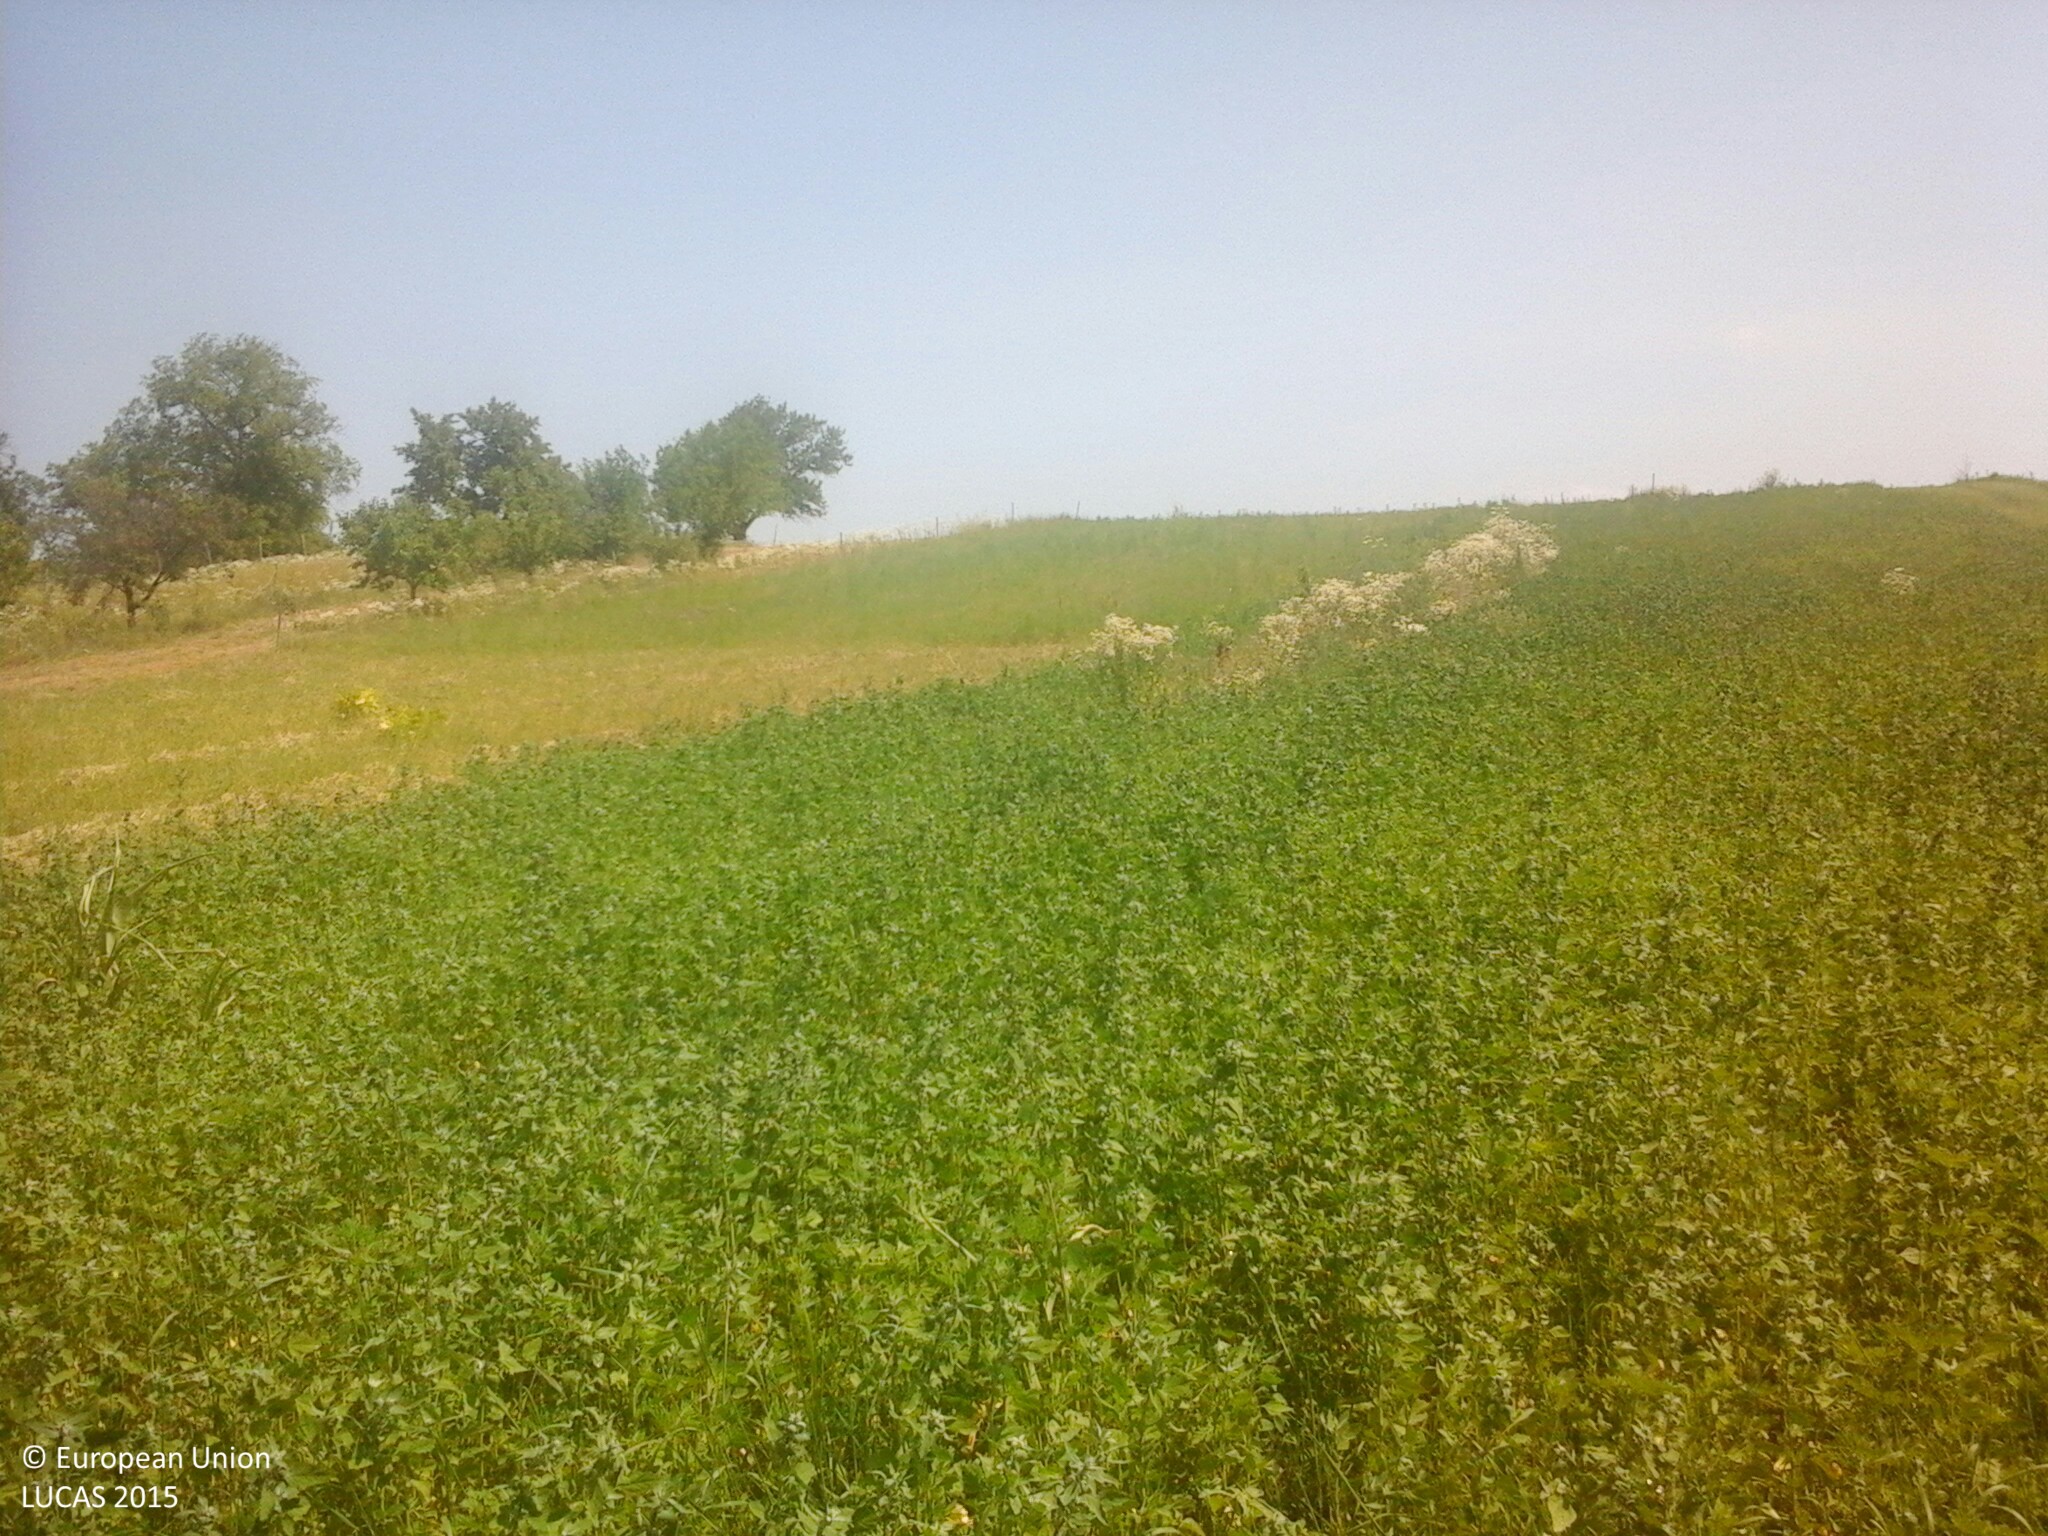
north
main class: Grassland
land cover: Spontaneously vegetated surfaces
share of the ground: > 75 %
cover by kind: herbaceous plants 100 %
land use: Agriculture (excluding fallow land and kitchen gardens)
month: July
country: HU
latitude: 47.4351
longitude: 18.5928
